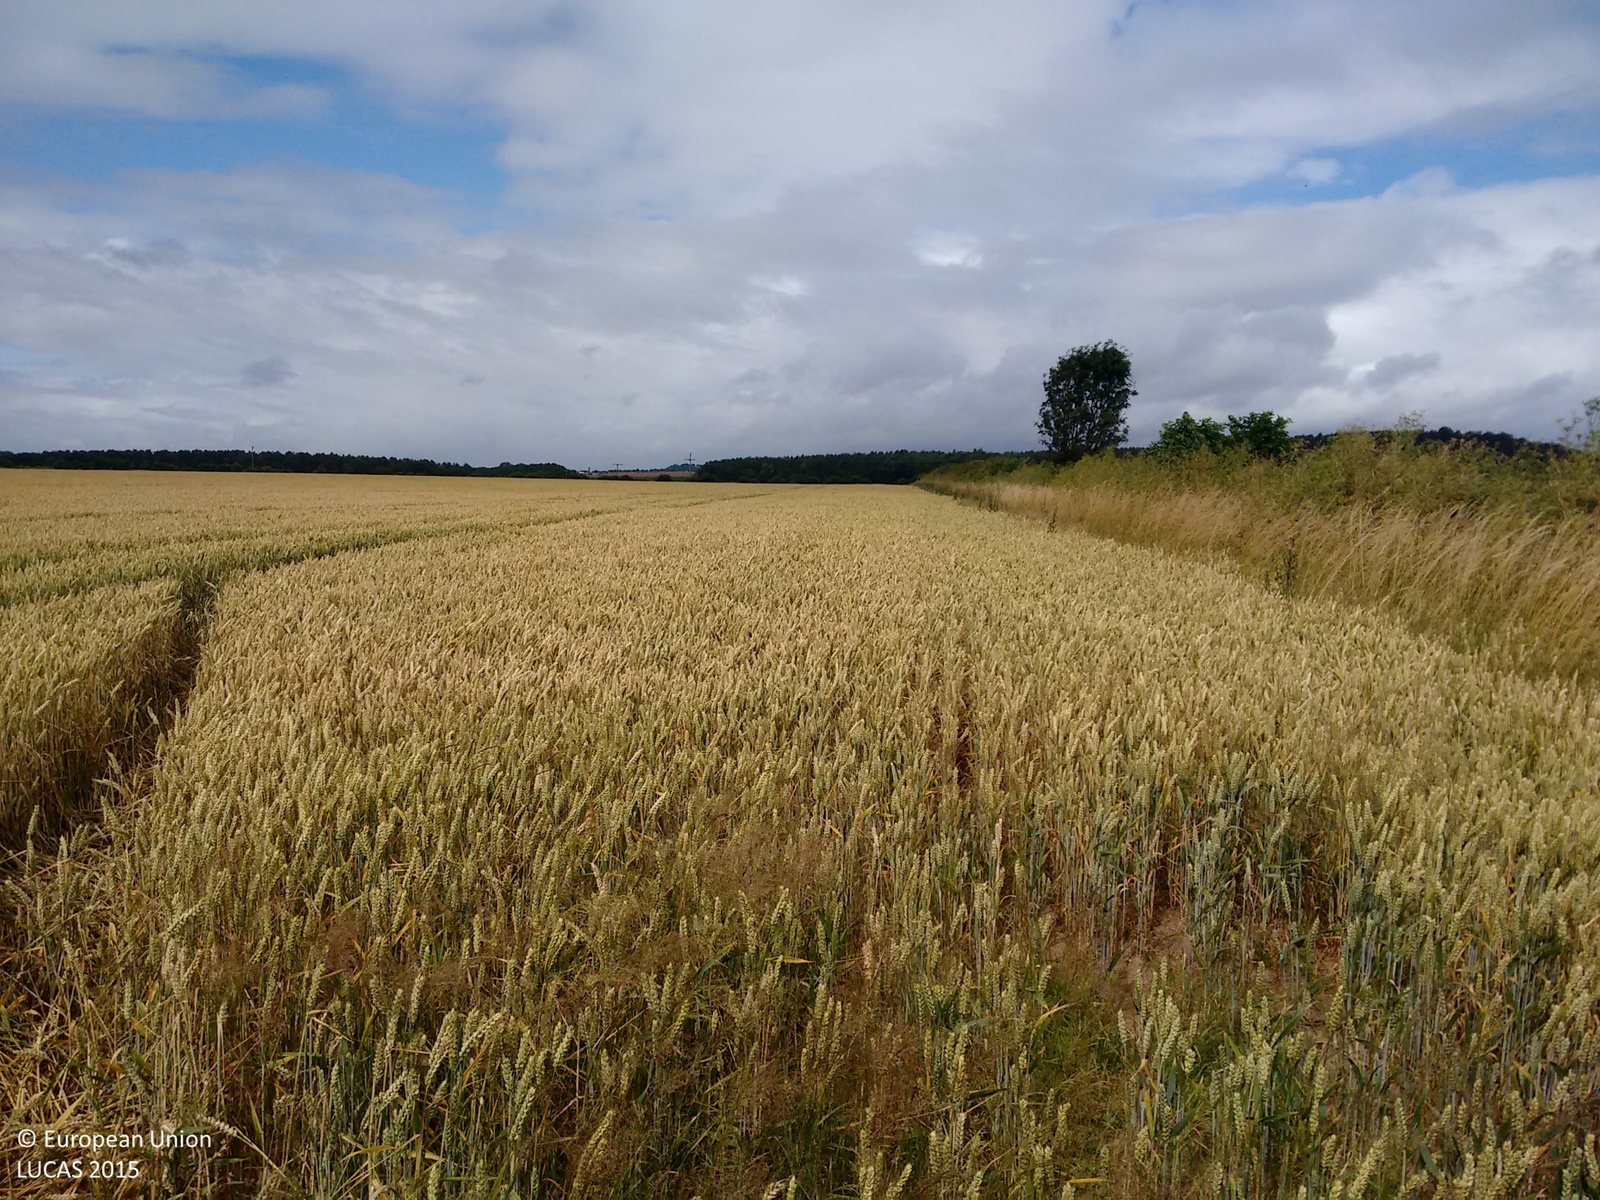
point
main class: Cropland
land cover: Common wheat
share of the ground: > 75 %
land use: Agriculture (excluding fallow land and kitchen gardens)
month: July
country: GB
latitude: 53.0915
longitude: -1.0797
